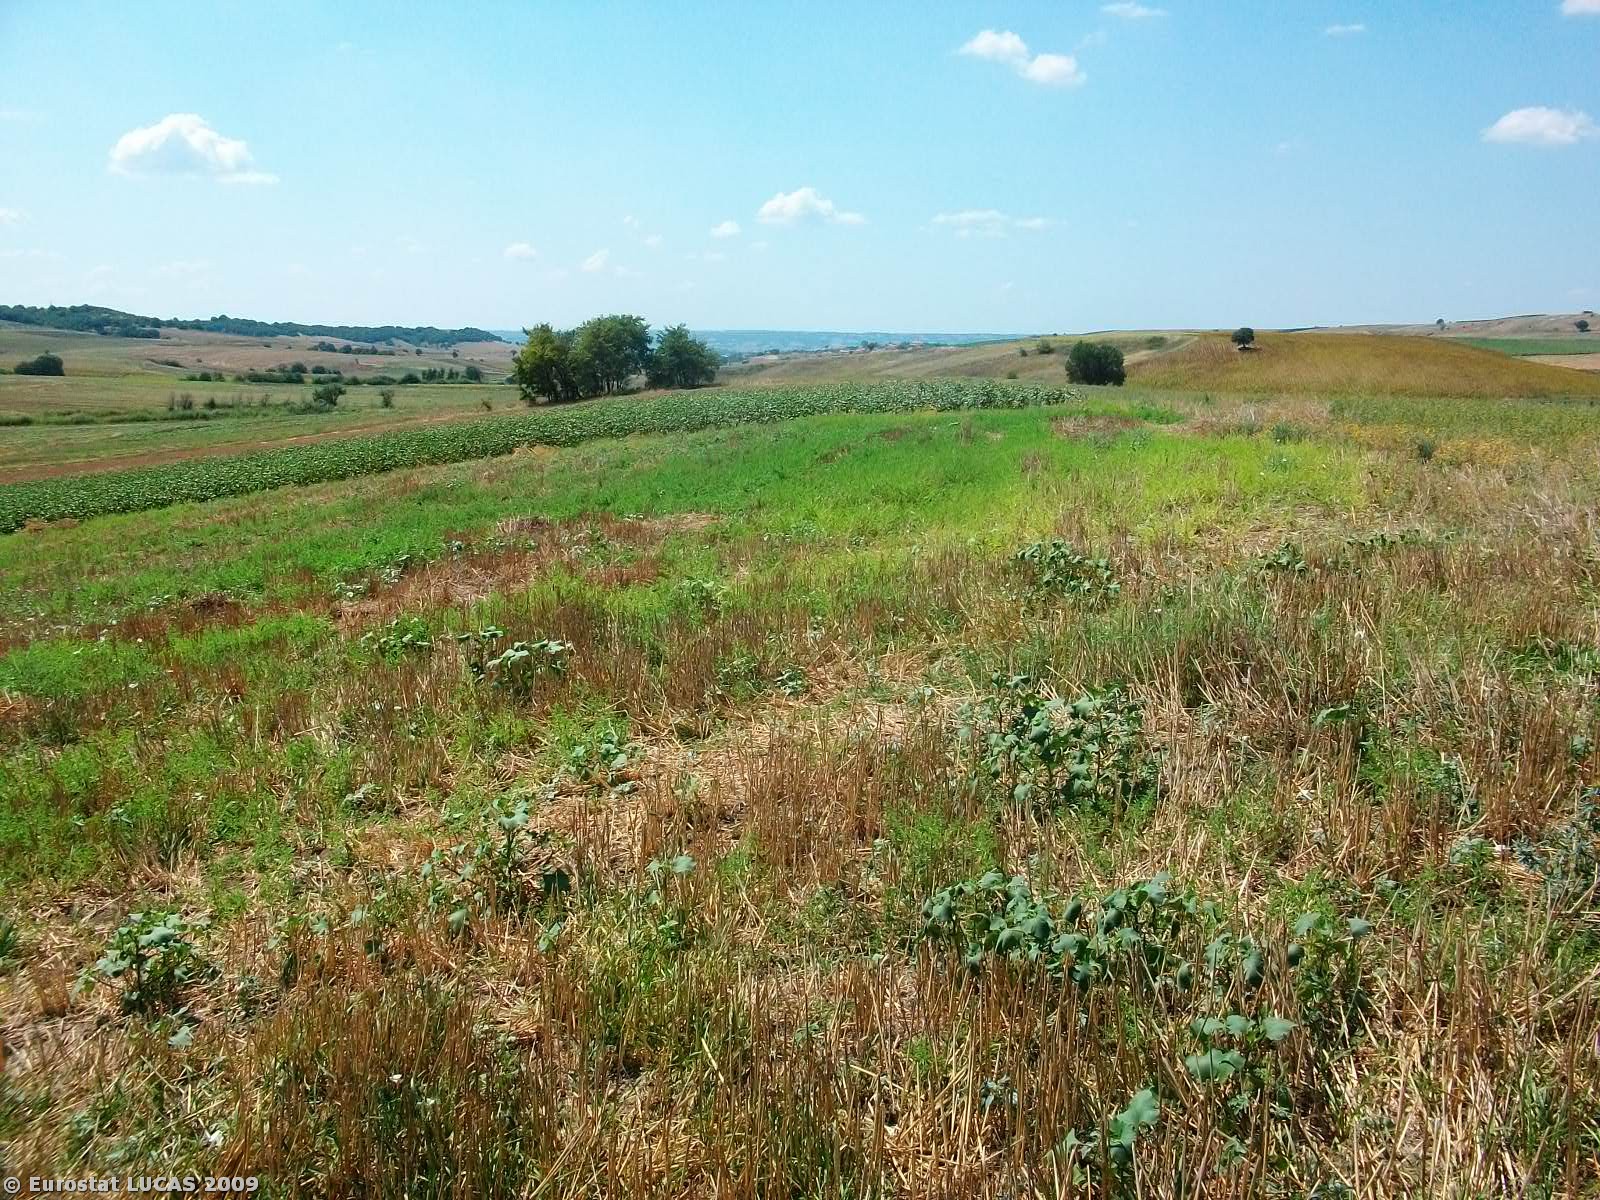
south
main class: Cropland
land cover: Common wheat
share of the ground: < 10 %
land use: Agriculture (excluding fallow land and kitchen gardens)
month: August
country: GR
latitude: 41.4335
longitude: 26.4111
